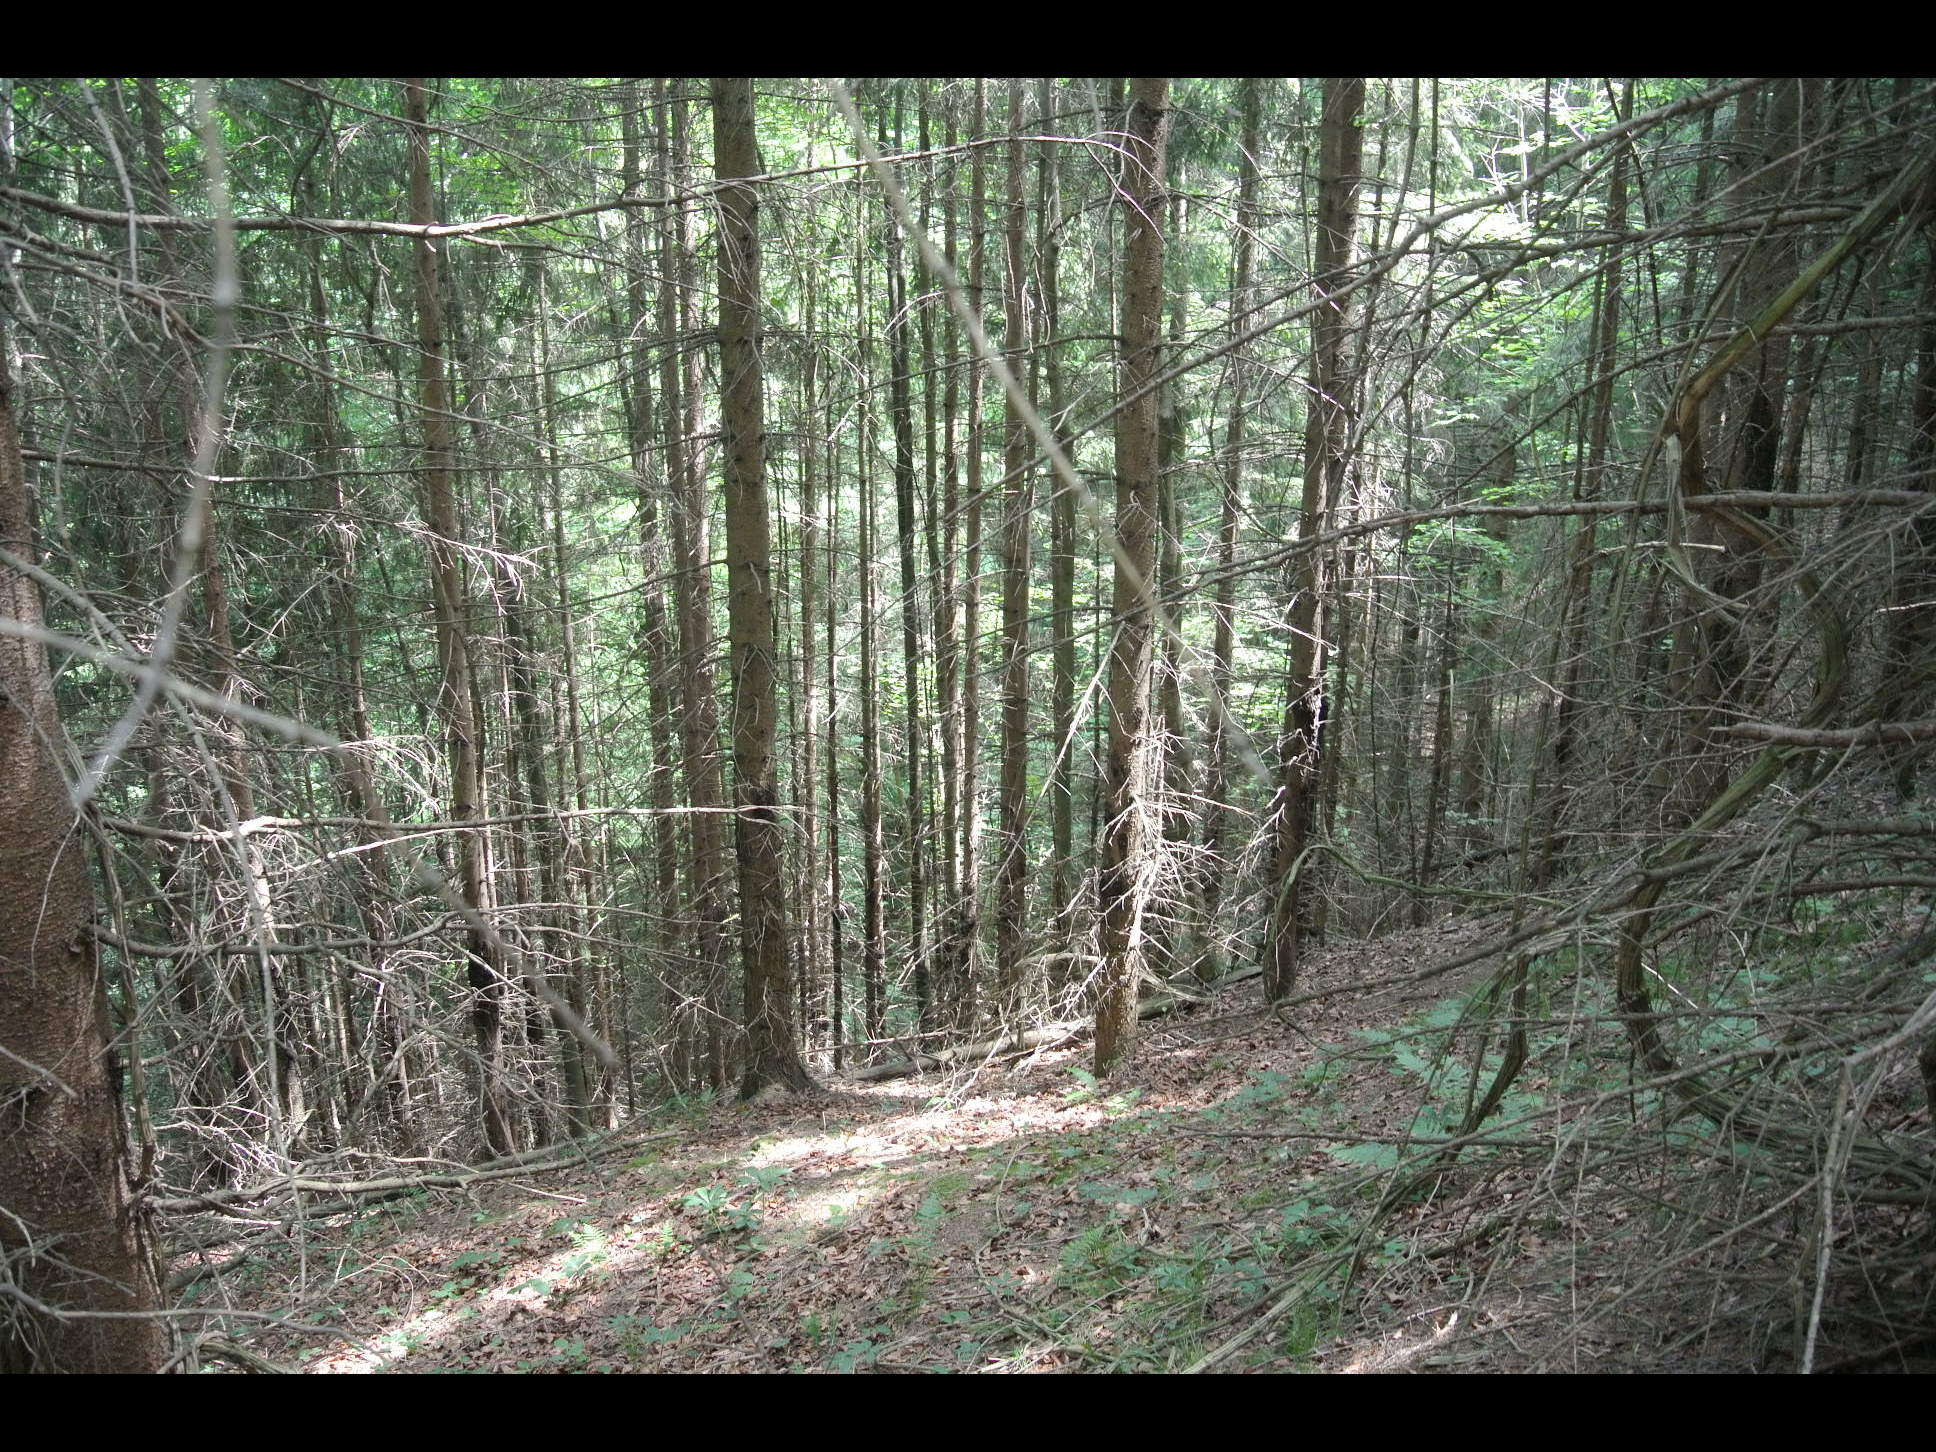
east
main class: Woodland
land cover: Spruce dominated coniferous woodland
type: alpine coniferous forest
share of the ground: > 75 %
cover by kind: coniferous forest trees 95 %, broadleaved forest trees 5 %
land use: Forestry
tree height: > 5 m
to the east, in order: Spruce dominated coniferous woodland; Broadleaved woodland; Spruce dominated mixed woodland
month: May
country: AT
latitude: 47.9970
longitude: 15.8326
